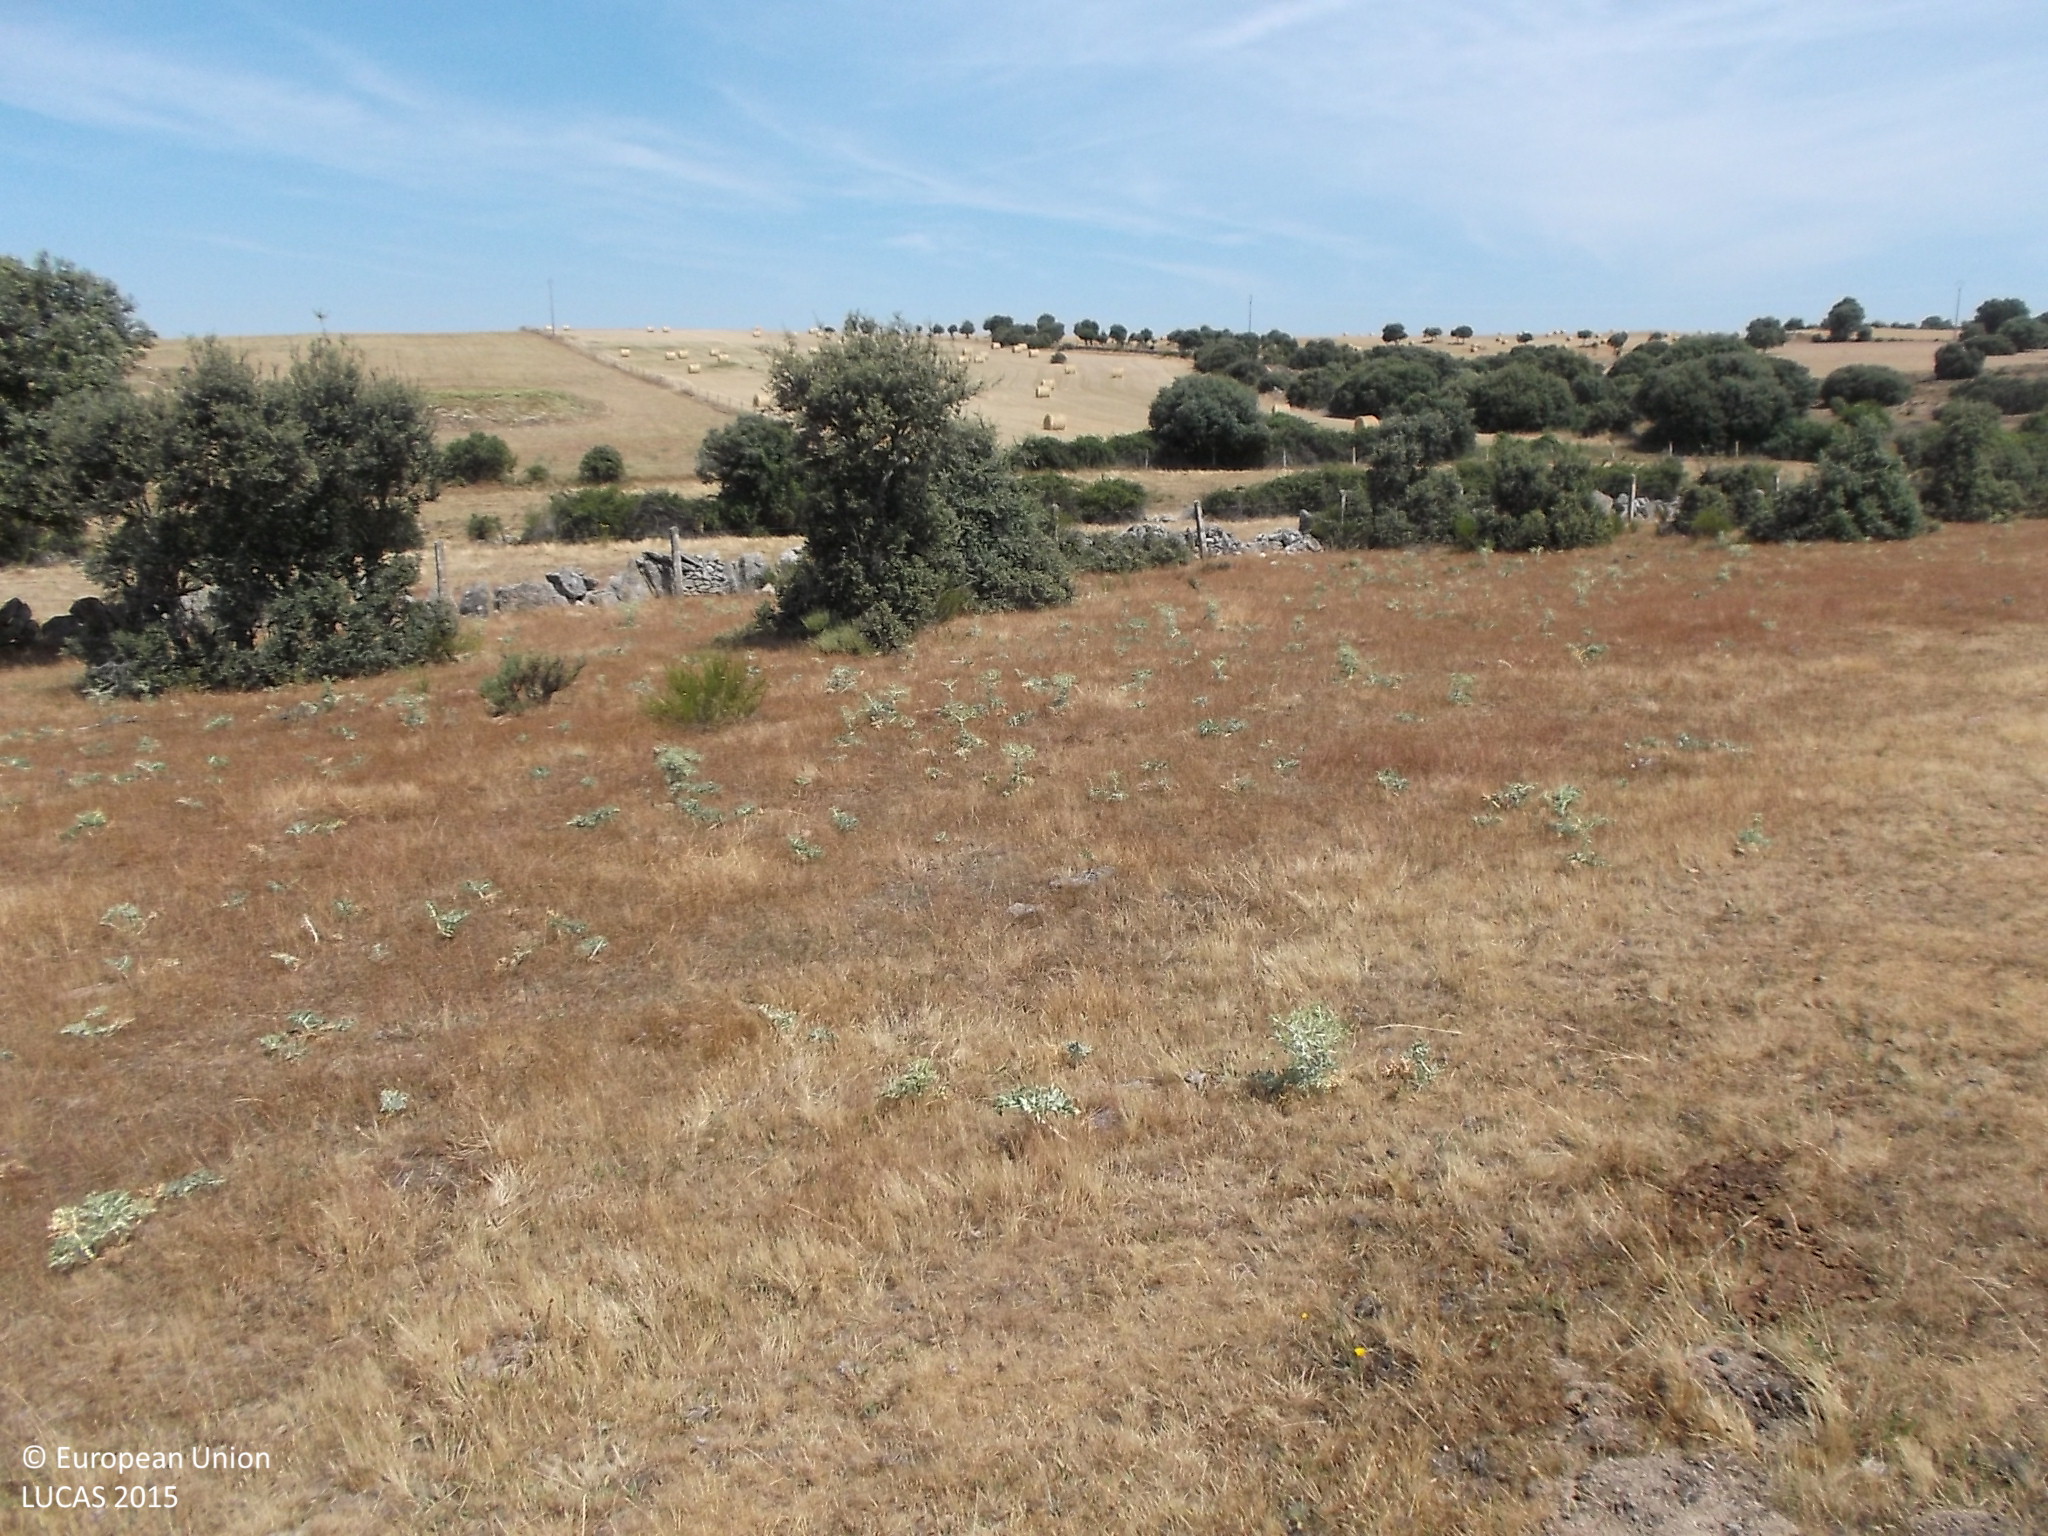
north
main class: Grassland
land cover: Grassland without tree/shrub cover
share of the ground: > 75 %
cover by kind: herbaceous plants 100 %
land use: Agriculture (excluding fallow land and kitchen gardens)
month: June
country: ES
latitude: 41.2309
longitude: -5.9663
